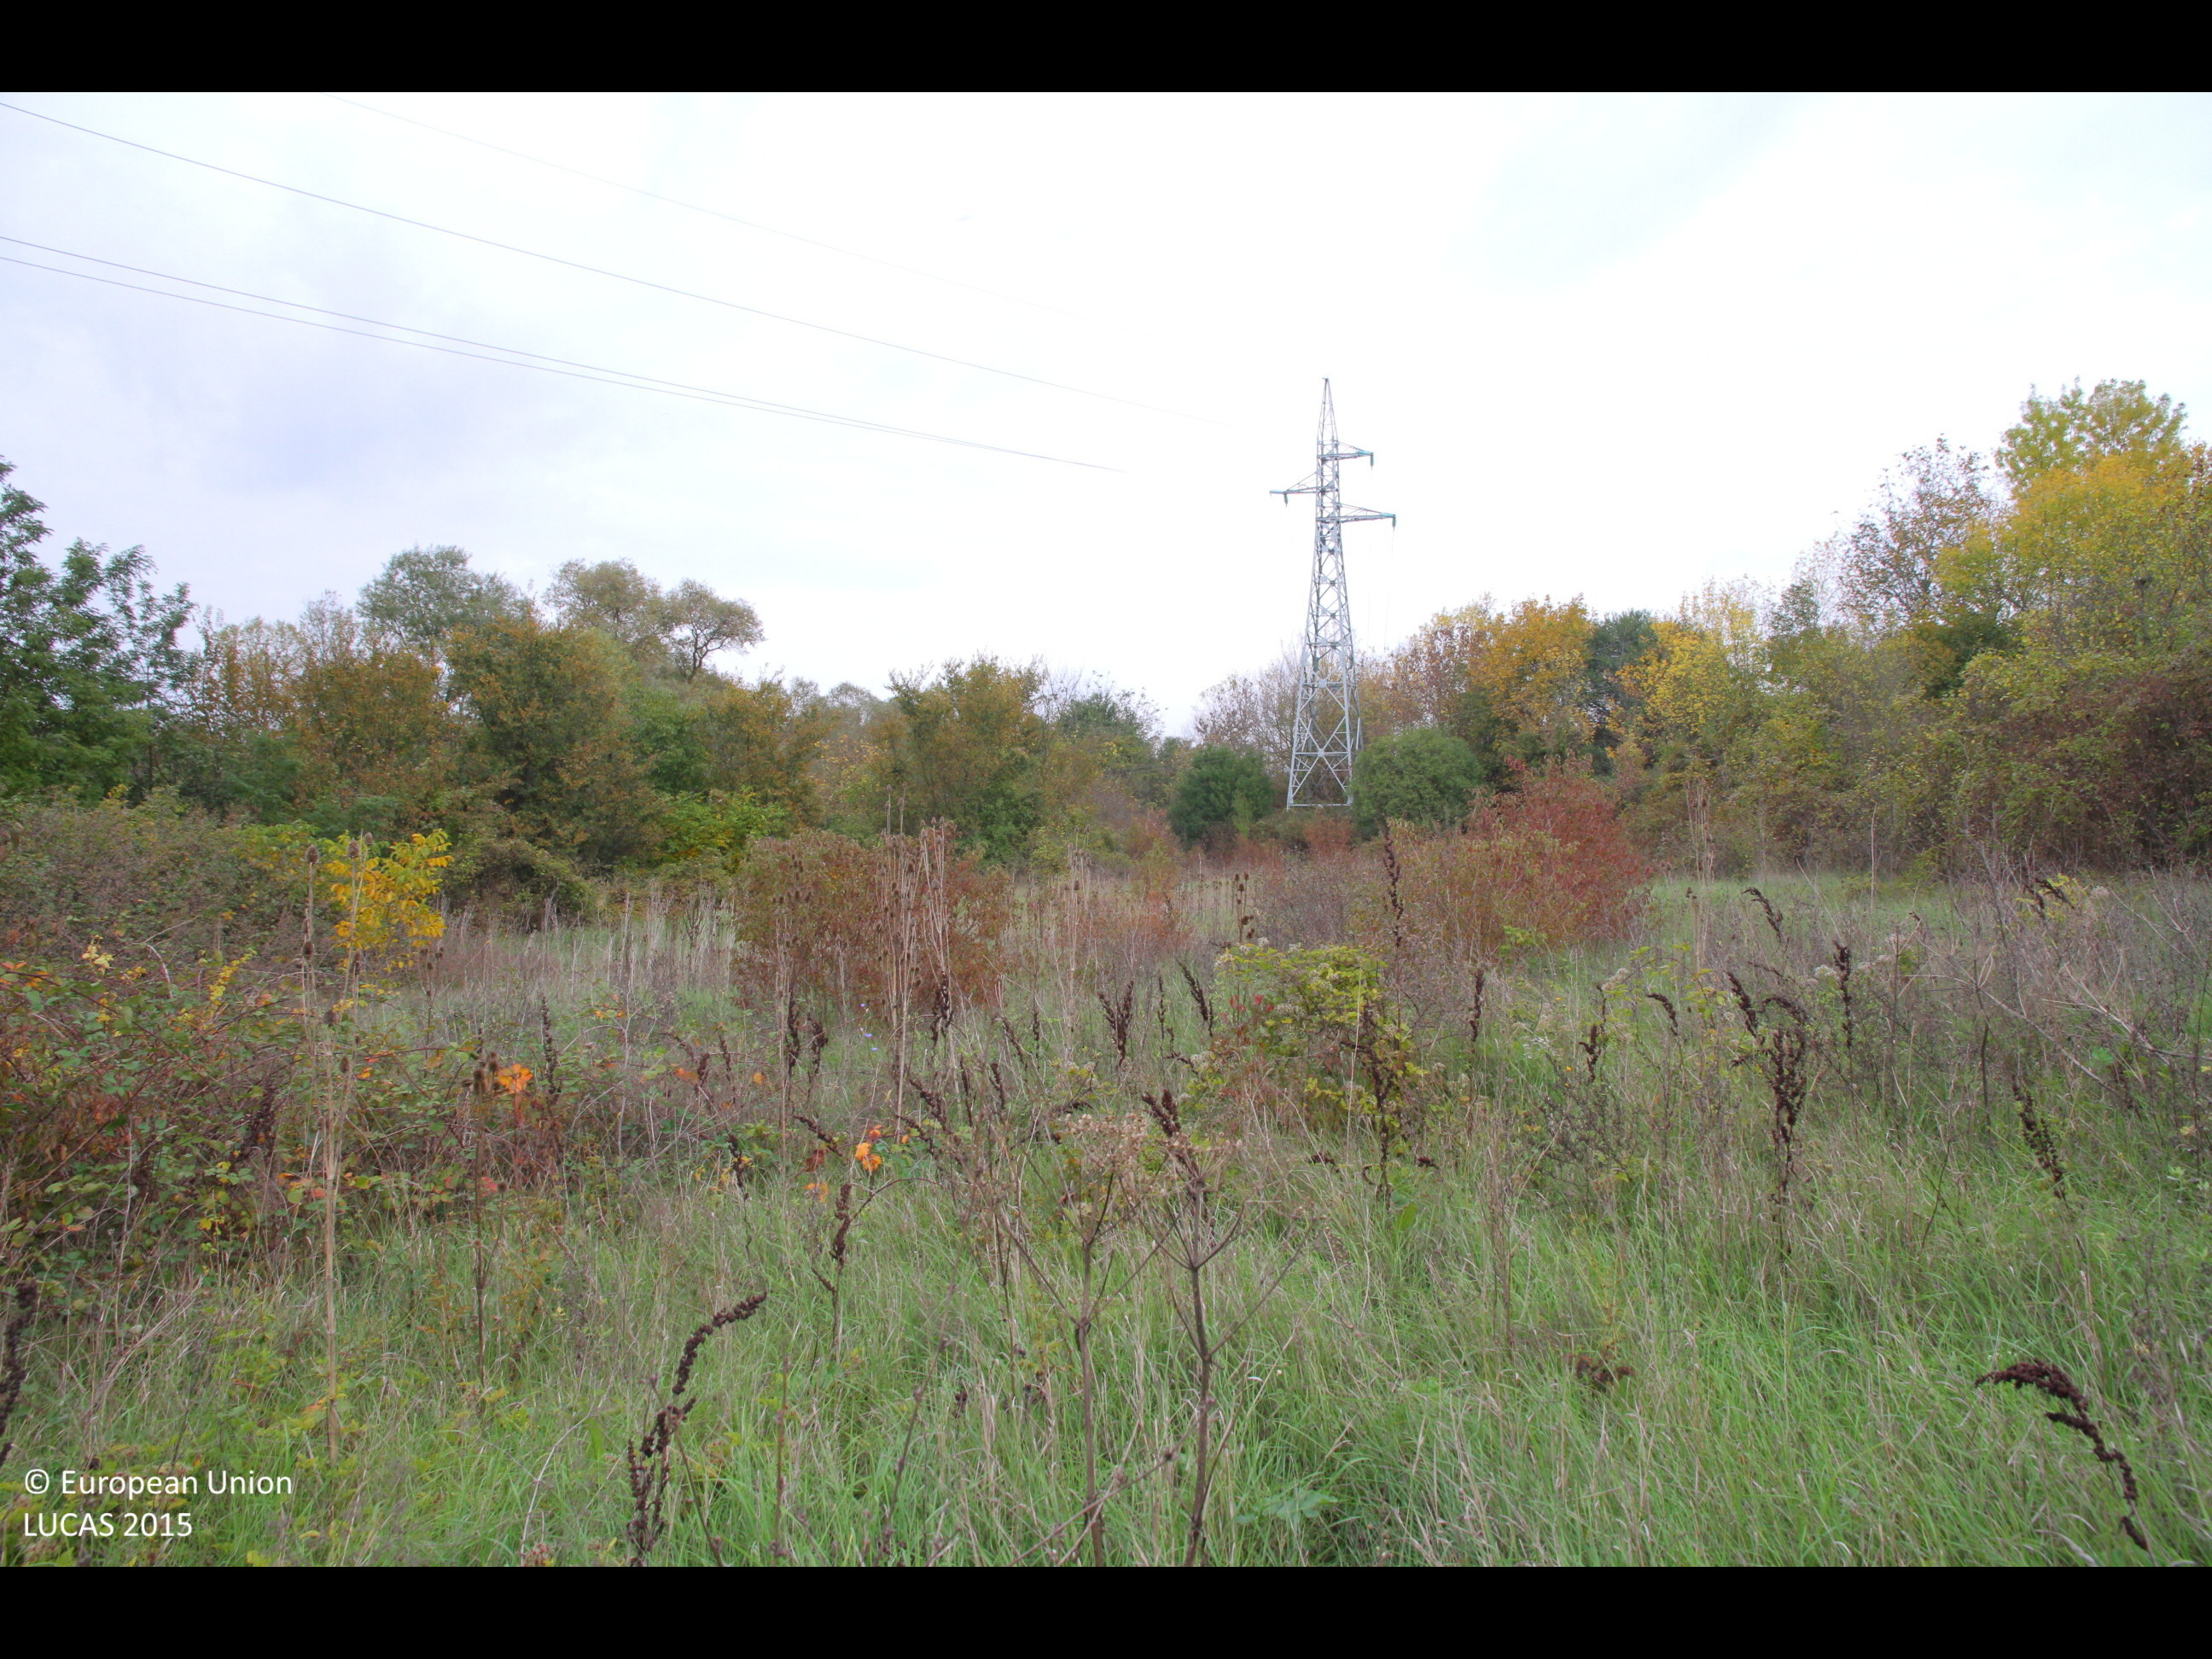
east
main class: Grassland
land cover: Grassland without tree/shrub cover
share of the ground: > 75 %
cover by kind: herbaceous plants 95 %, shrubs 5 %
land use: Semi-natural and natural areas not in use
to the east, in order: Grassland without tree/shrub cover; Electric lines; Broadleaved woodland; Rivers and streams; Broadleaved woodland; Grass margins; Paved roads, cycling and walking lanes
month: October
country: BG
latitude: 43.2912
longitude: 26.9623
